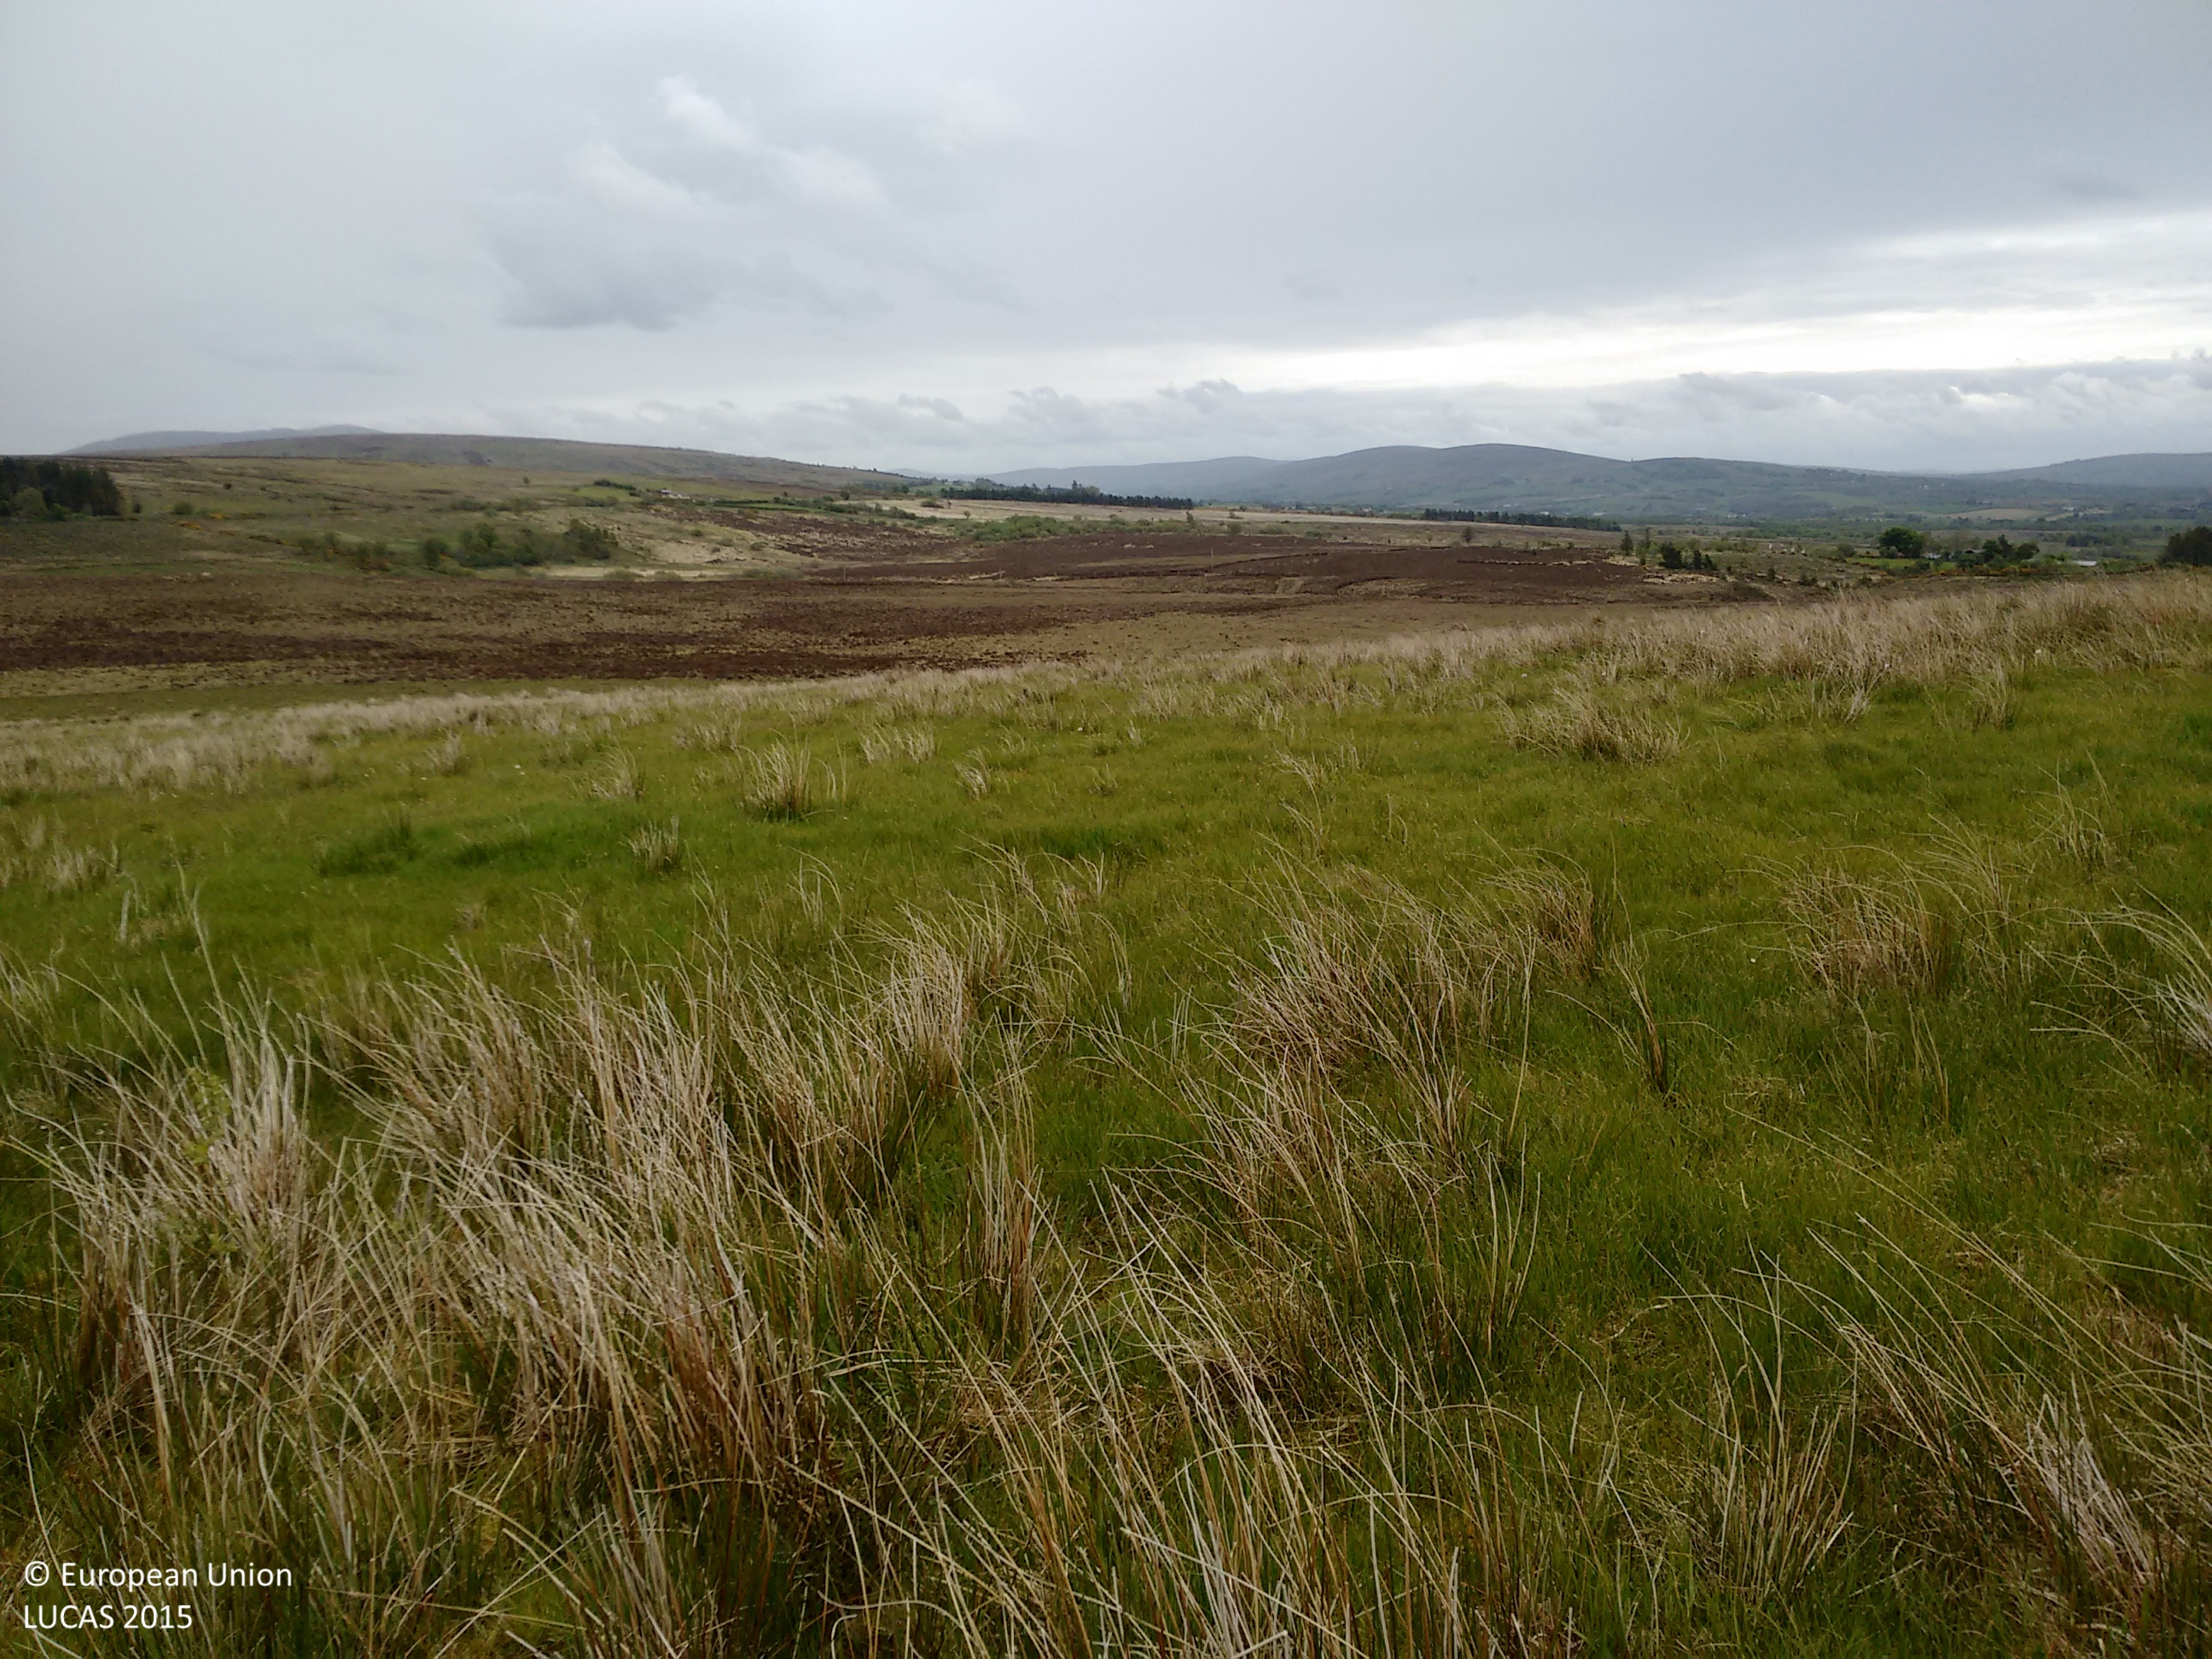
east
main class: Grassland
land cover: Grassland without tree/shrub cover
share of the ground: > 75 %
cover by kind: herbaceous plants 100 %
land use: Agriculture (excluding fallow land and kitchen gardens)
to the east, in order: Grassland without tree/shrub cover; Fences; Grassland without tree/shrub cover
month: June
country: GB
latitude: 54.7736
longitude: -7.3269
